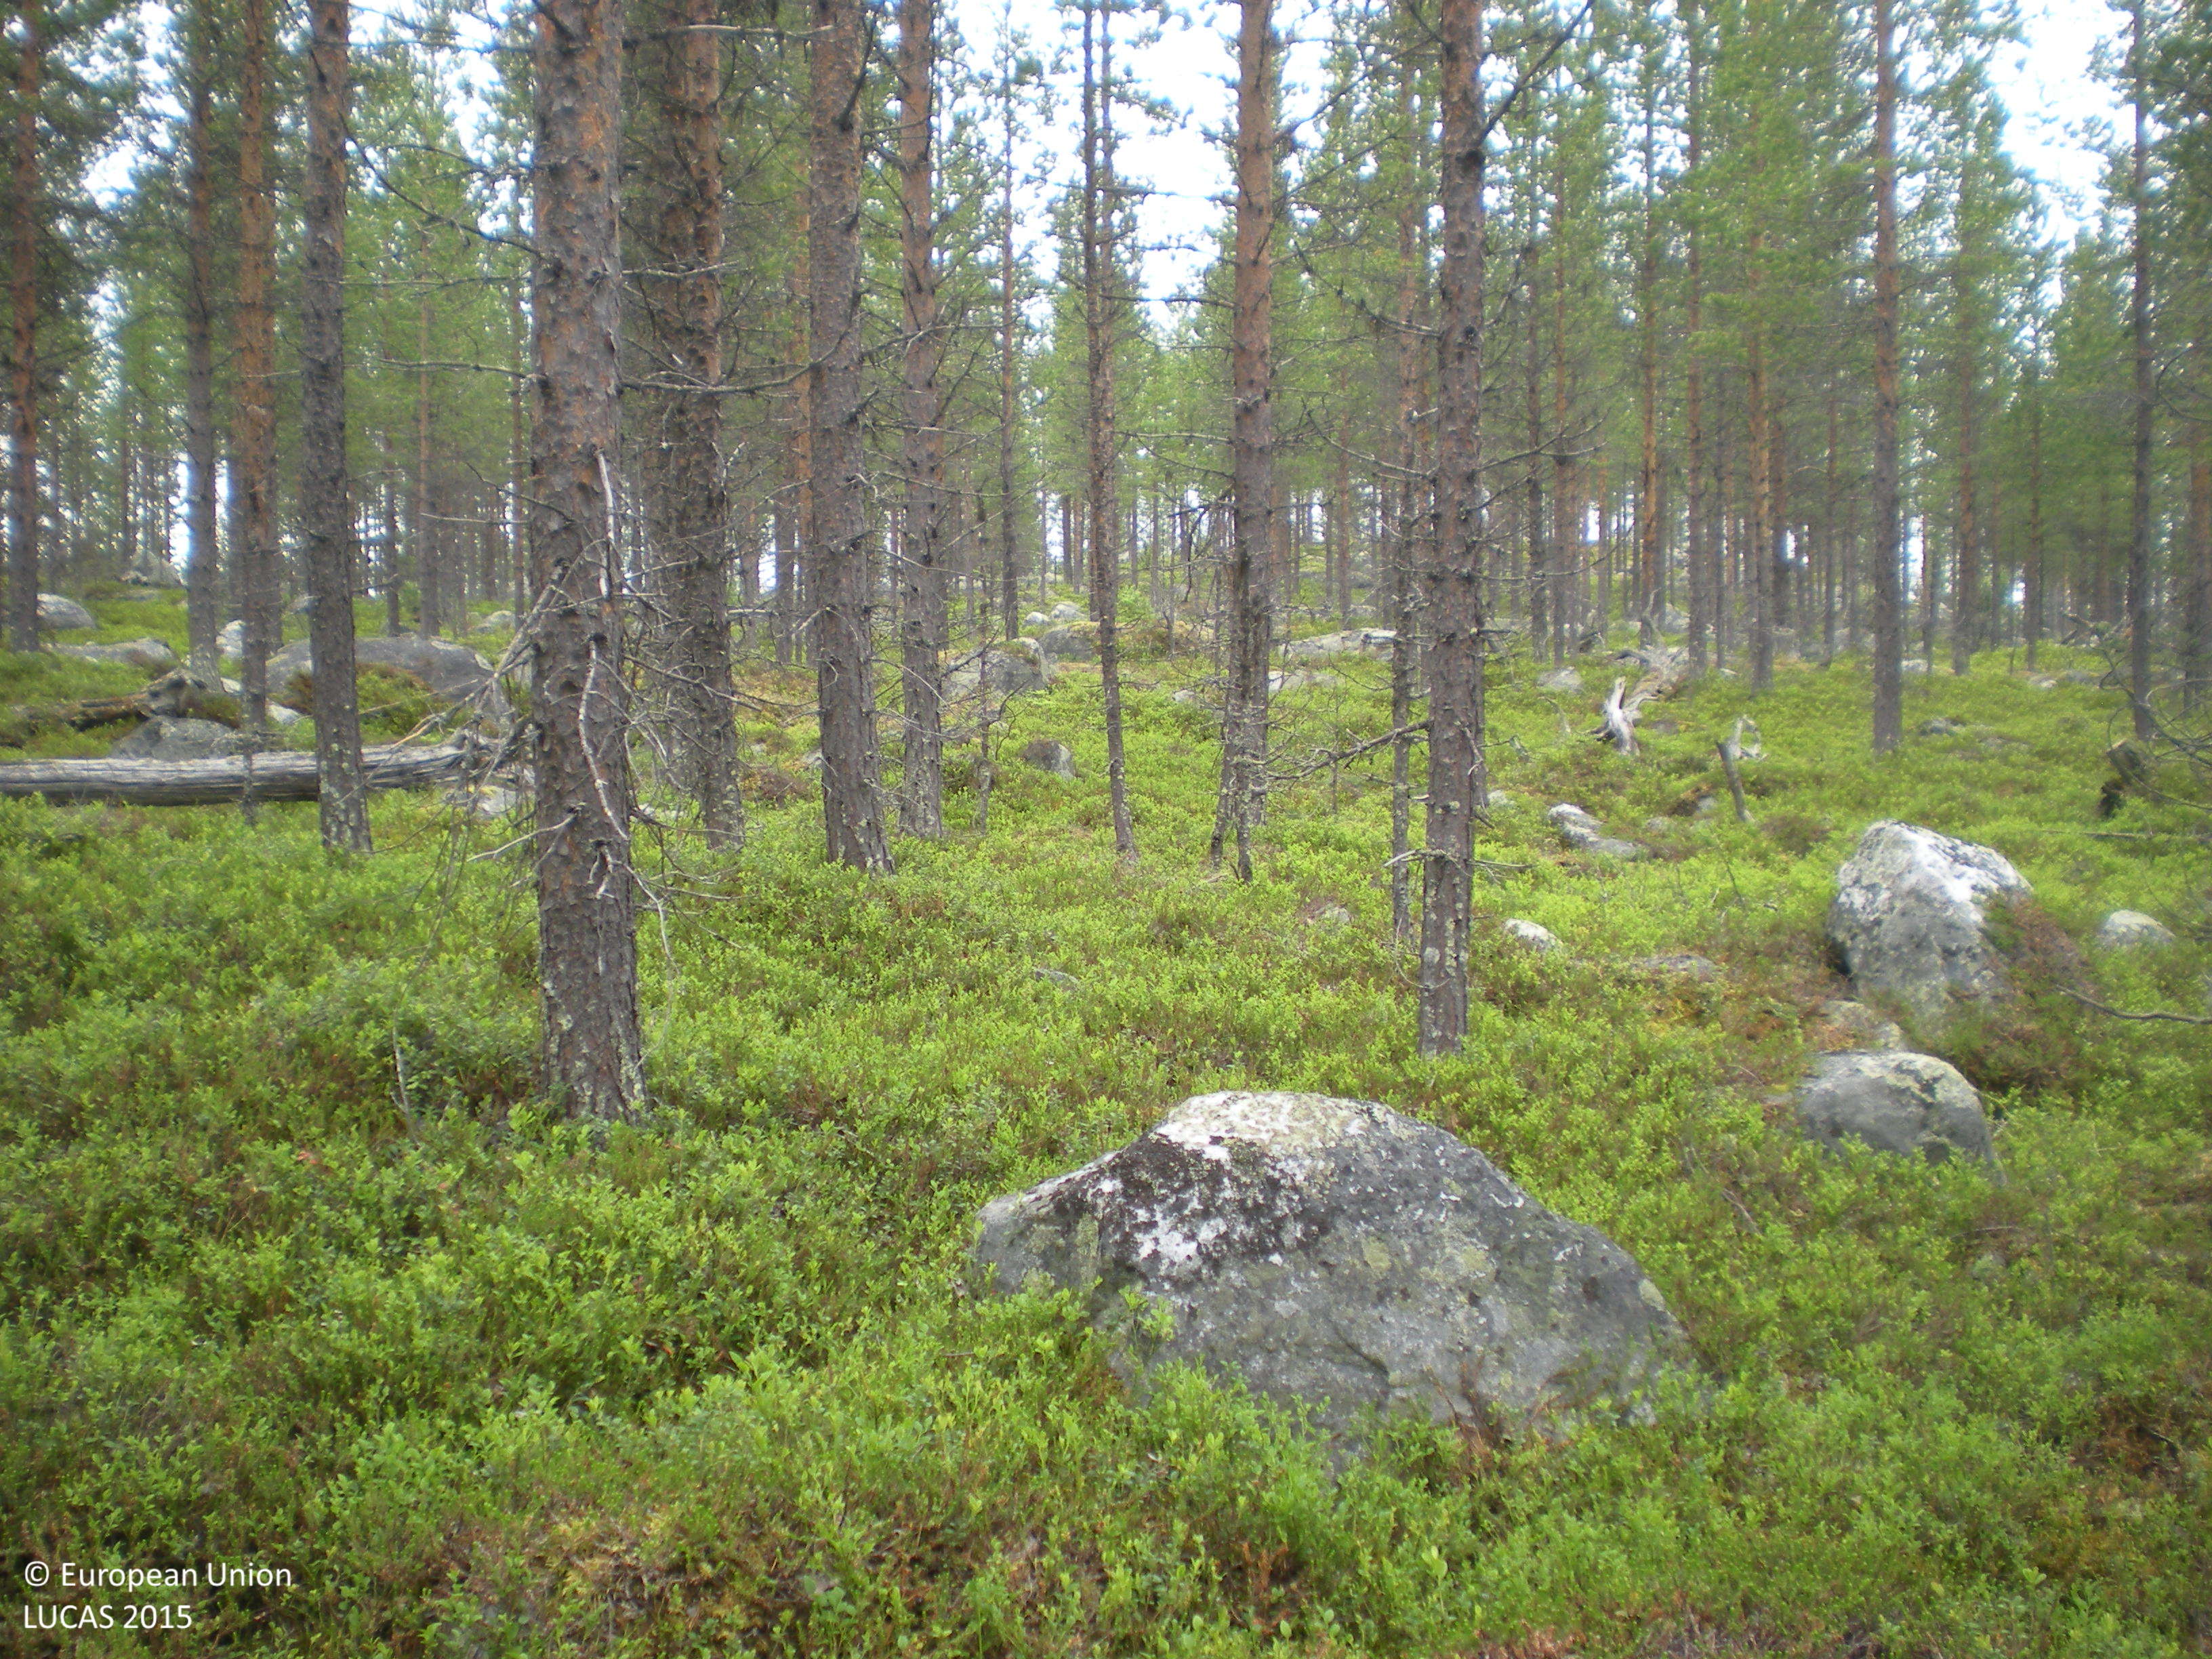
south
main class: Woodland
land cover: Pine dominated coniferous woodland
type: boreal forest
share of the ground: 50 - 75 %
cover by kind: coniferous forest trees 55 %, shrubs 30 %, consolidated bare surface 10 %, lichens and mosses 5 %
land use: Forestry
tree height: > 5 m
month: July
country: SE
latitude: 65.5109
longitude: 17.0733
